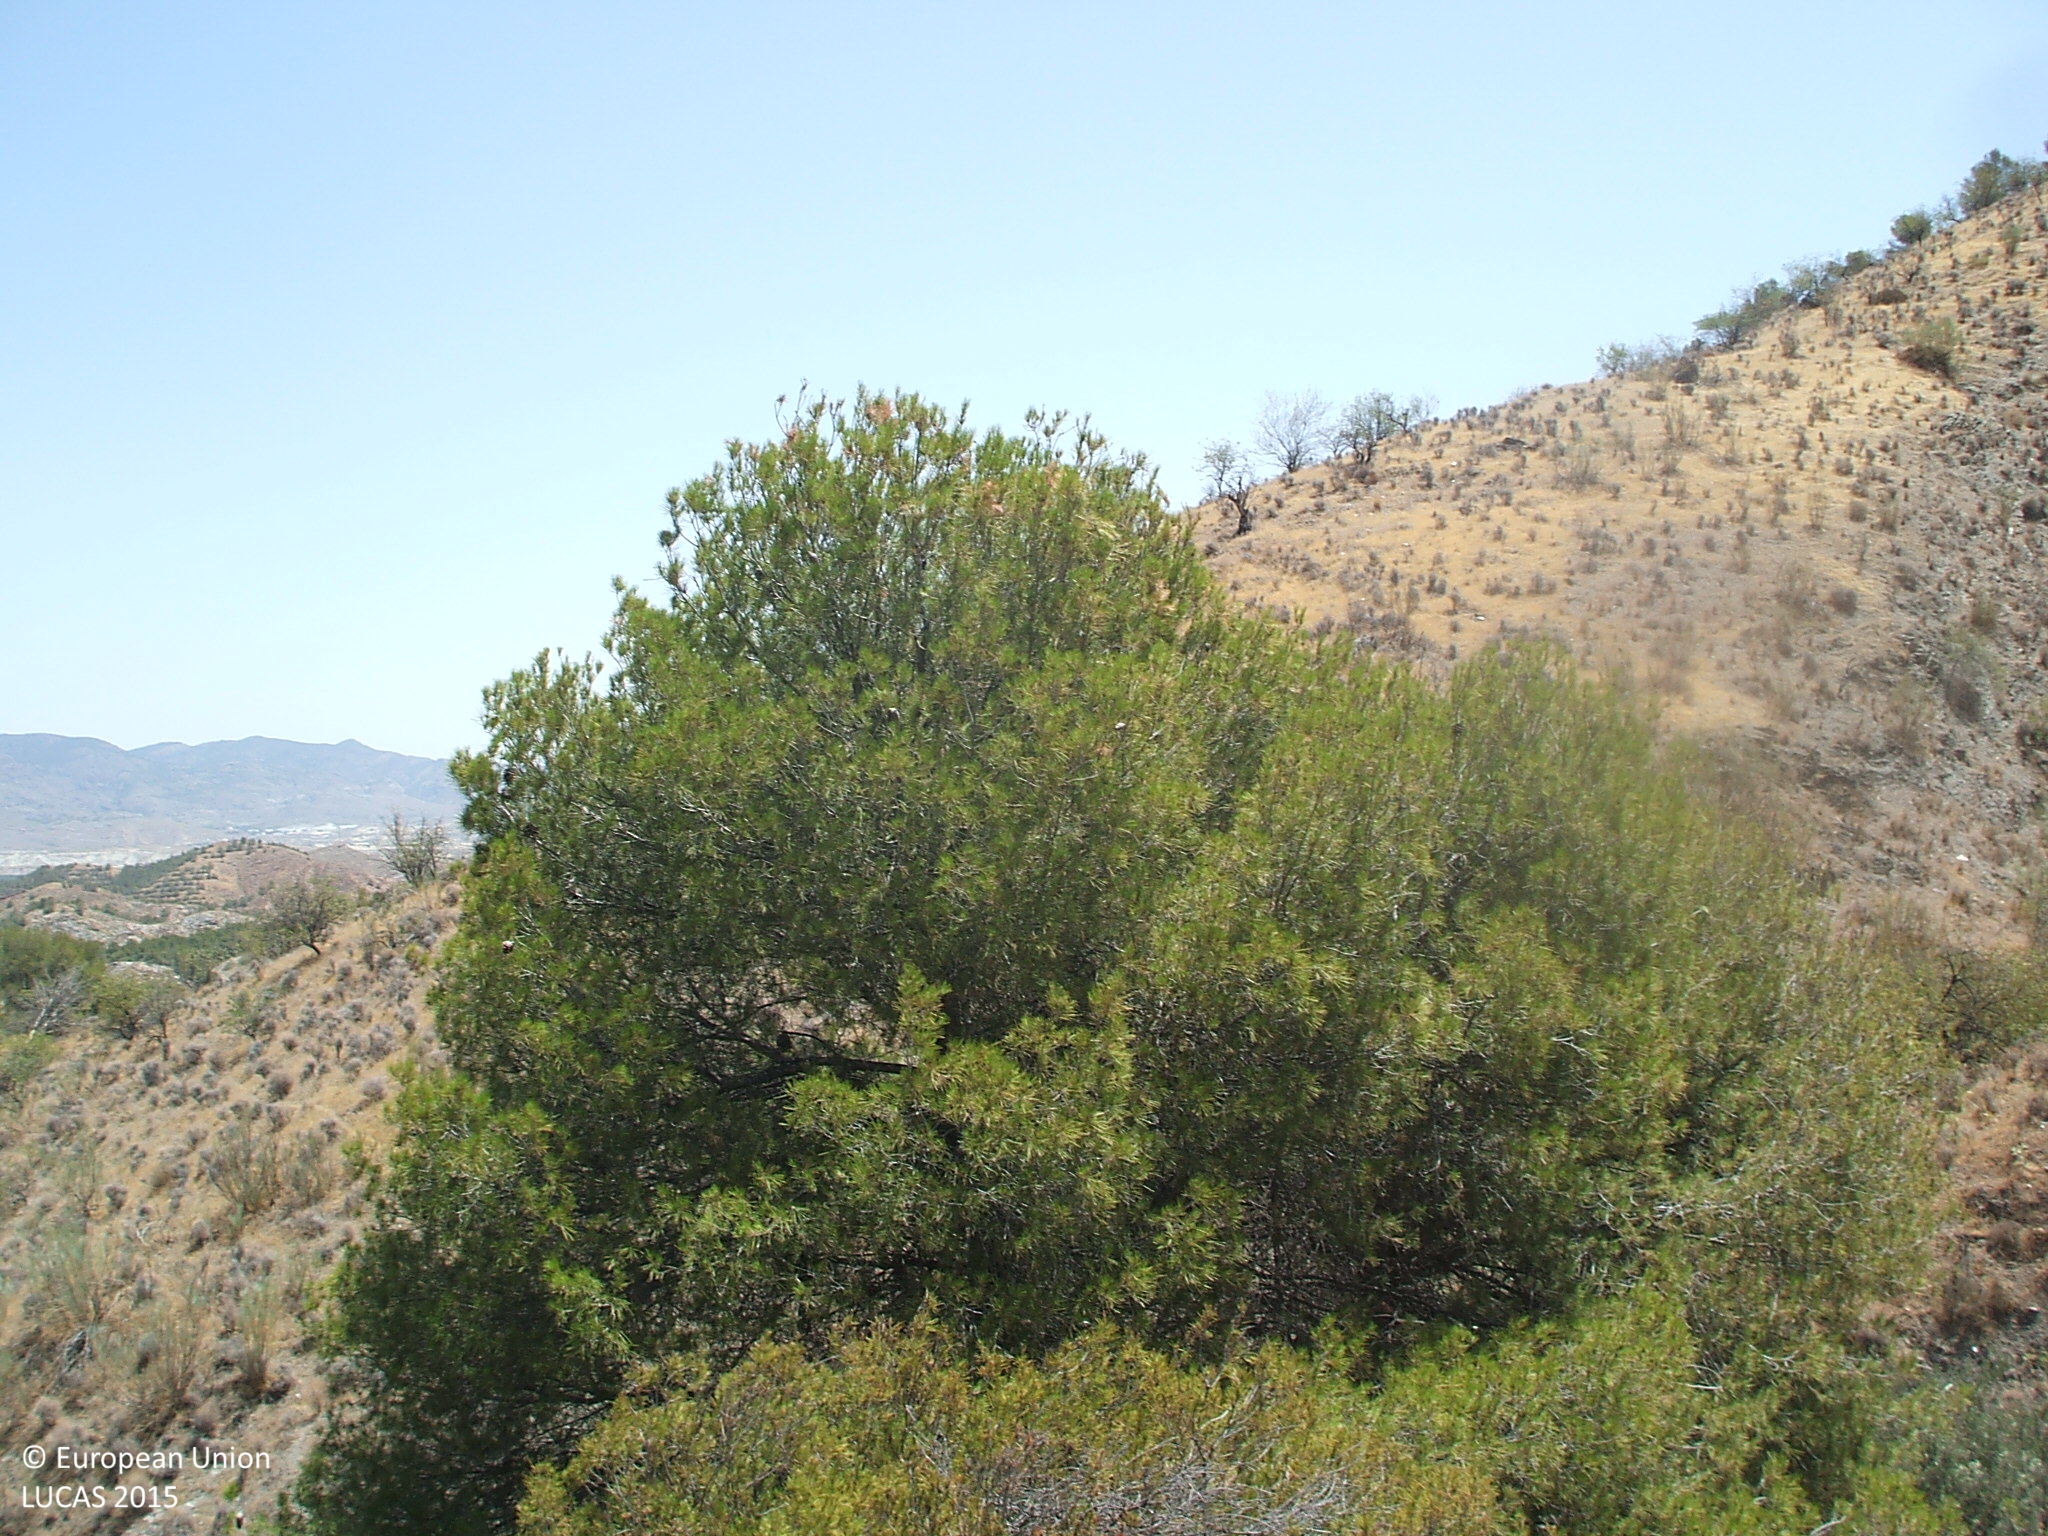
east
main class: Woodland
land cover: Pine dominated coniferous woodland
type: coniferous forest of the mediterranean region
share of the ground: 25 - 50 %
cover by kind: consolidated bare surface 50 %, coniferous forest trees 30 %, shrubs 20 %
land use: Semi-natural and natural areas not in use
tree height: > 5 m
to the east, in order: Pine dominated coniferous woodland; Olive groves; Shrubland without tree cover; Nuts trees; Pine dominated coniferous woodland
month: July
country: ES
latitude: 37.3375
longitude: -2.3866
